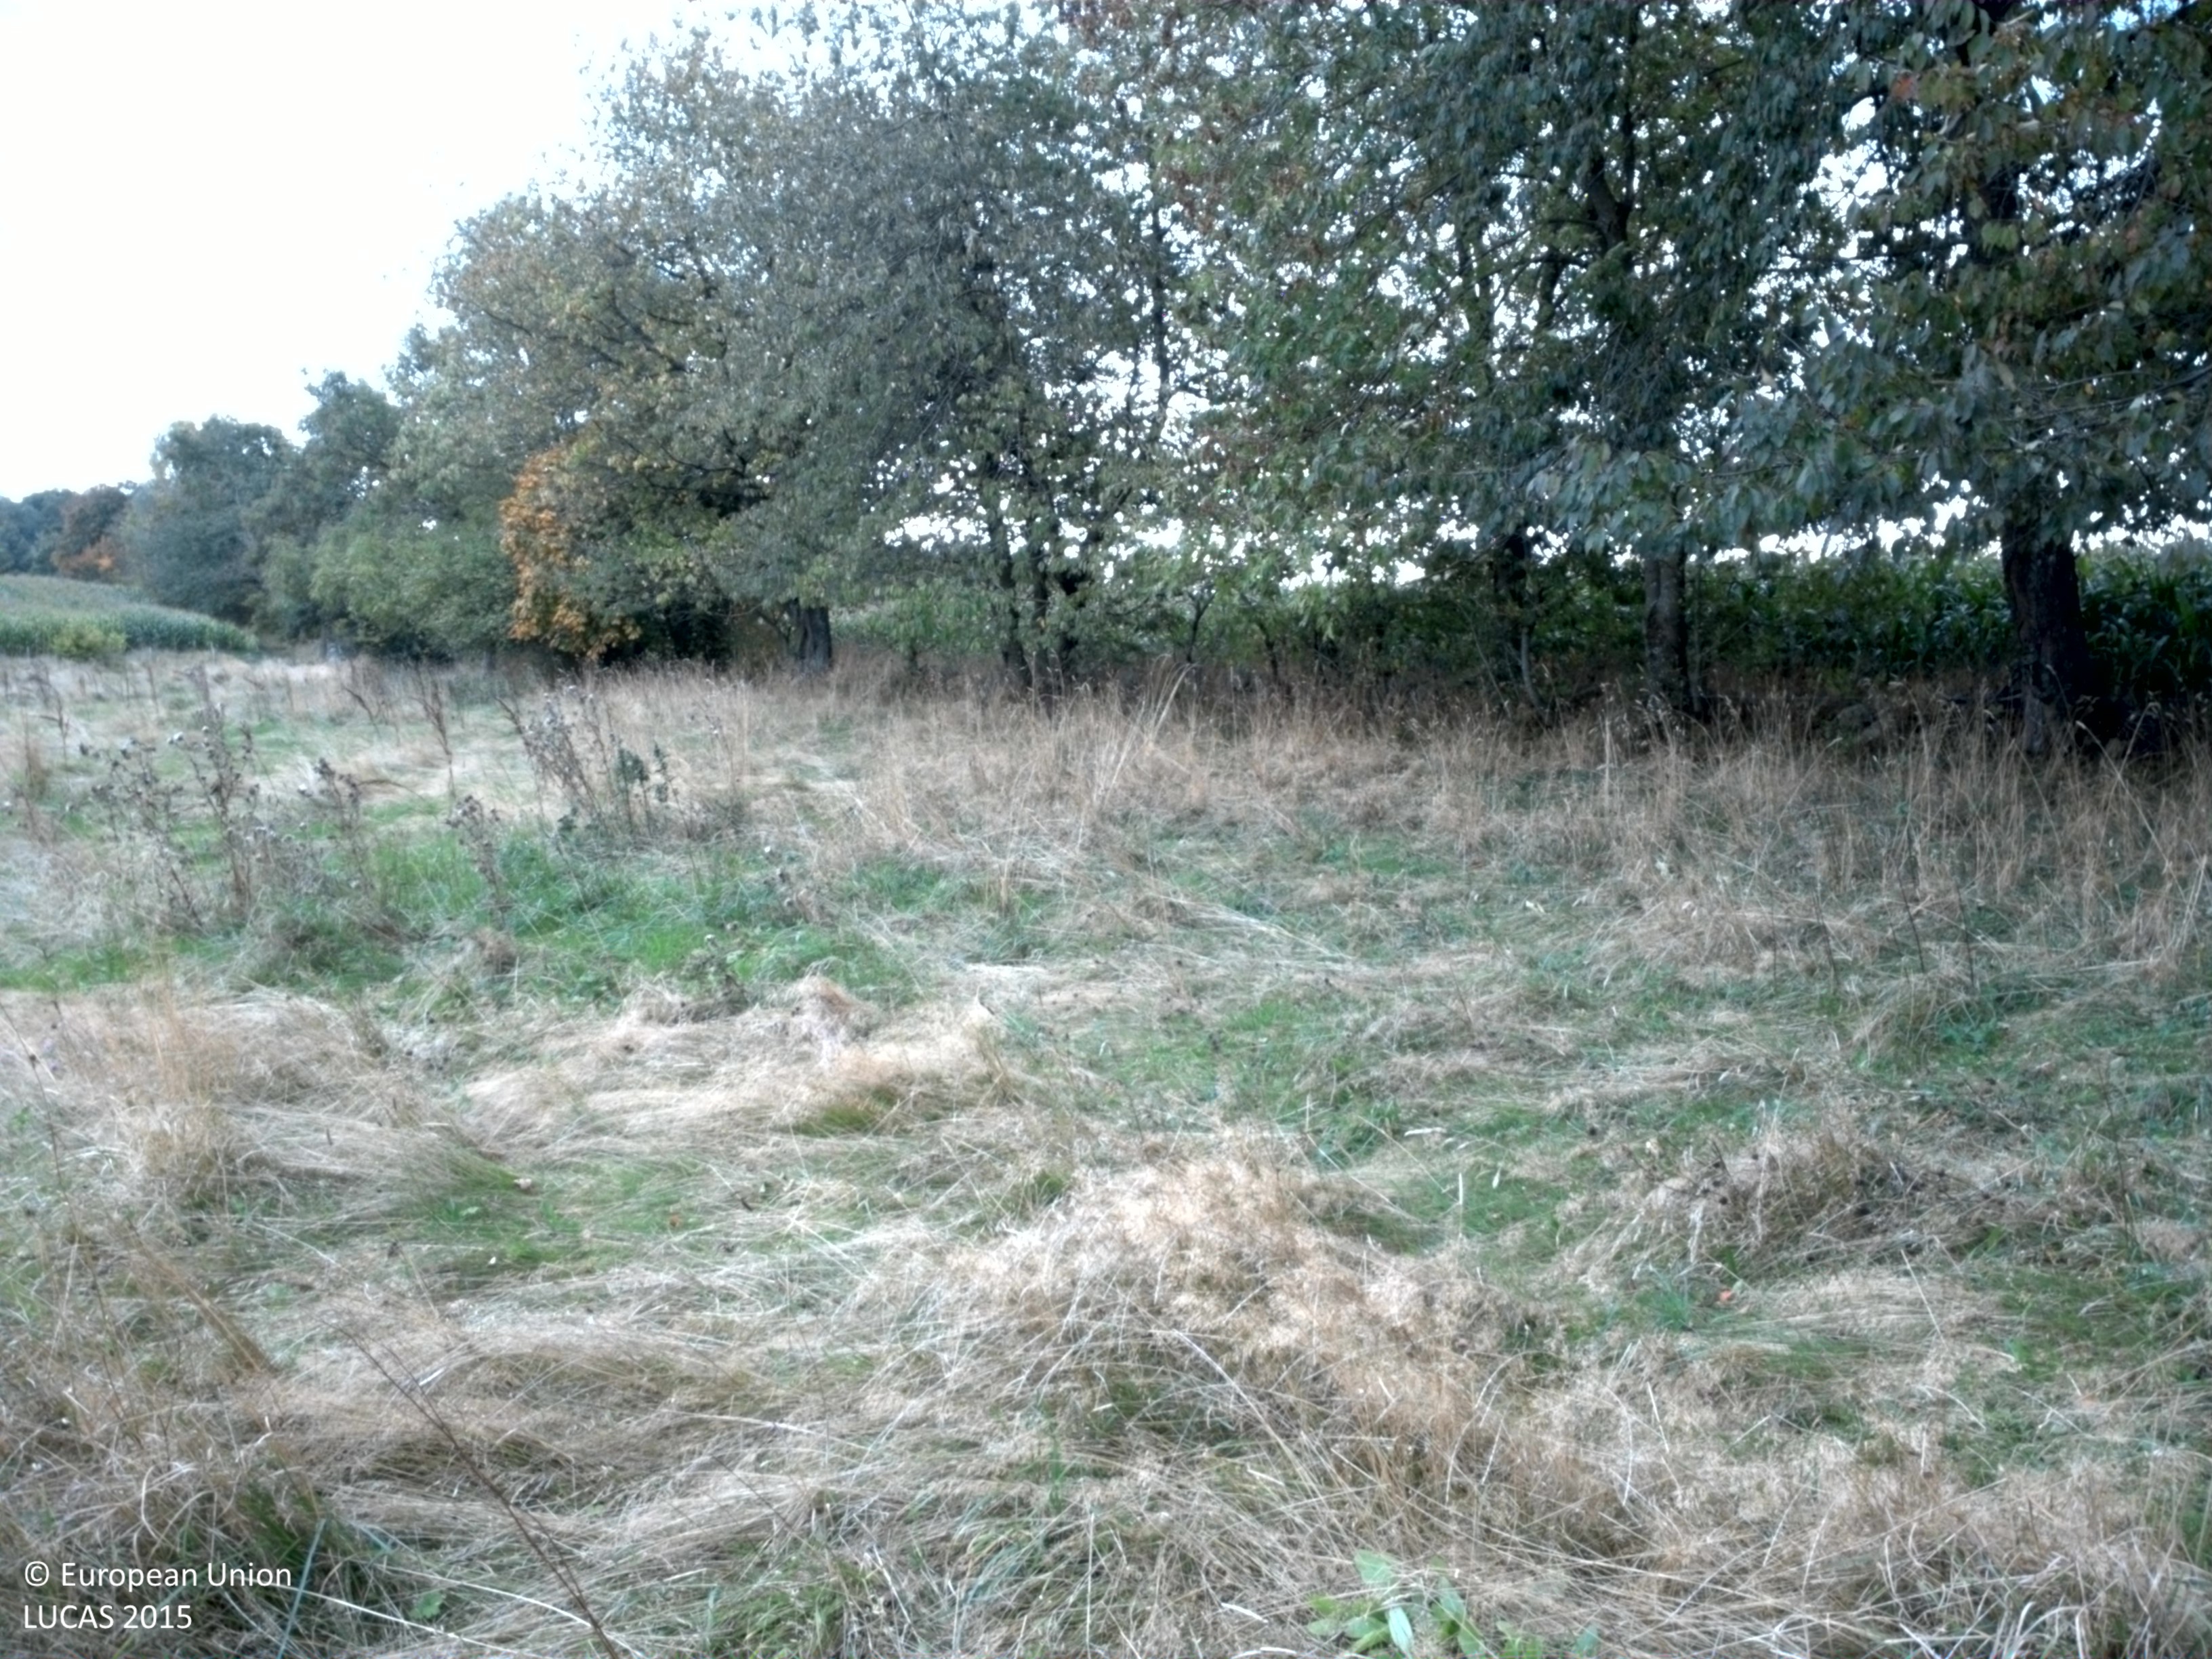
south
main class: Grassland
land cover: Grassland without tree/shrub cover
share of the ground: > 75 %
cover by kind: herbaceous plants 100 %
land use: Agriculture (excluding fallow land and kitchen gardens)
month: October
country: SE
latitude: 55.6148
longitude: 14.2060
